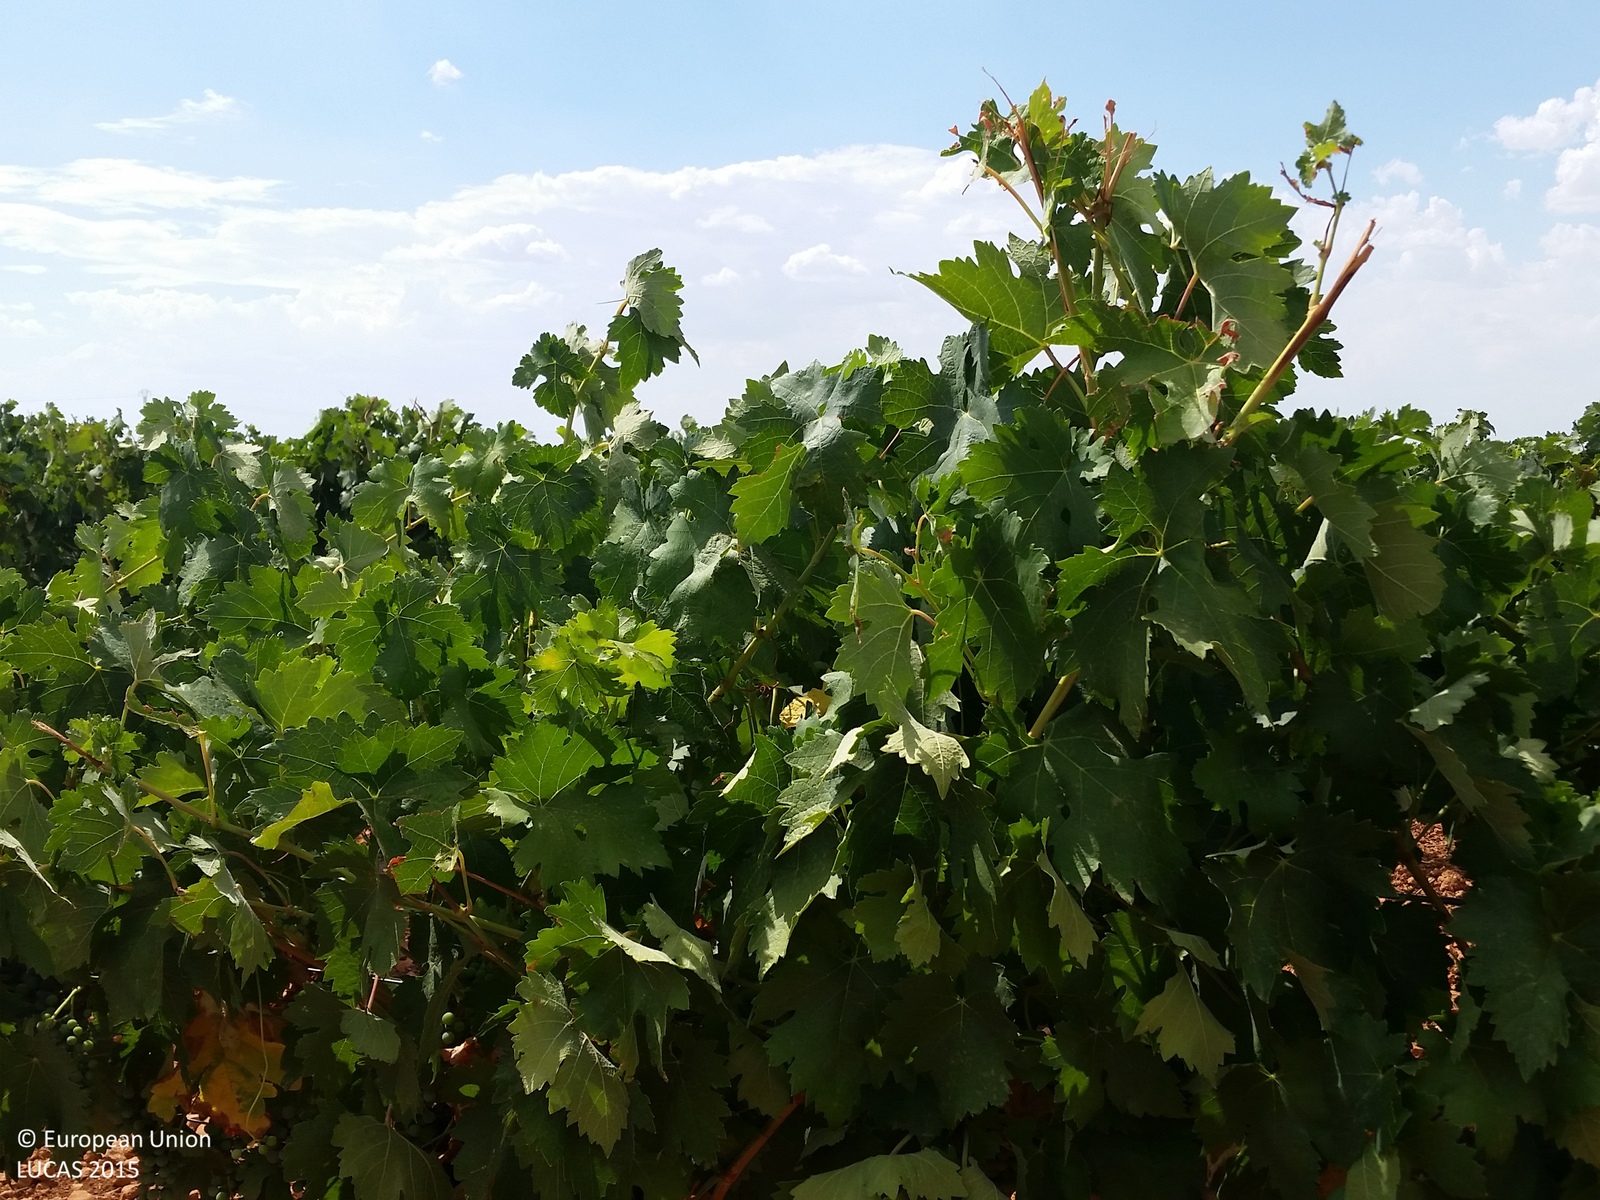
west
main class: Cropland
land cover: Vineyards
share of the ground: 50 - 75 %
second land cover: Other bare soil
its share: > 75 %
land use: Agriculture (excluding fallow land and kitchen gardens)
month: July
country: ES
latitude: 39.2257
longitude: -2.6476
